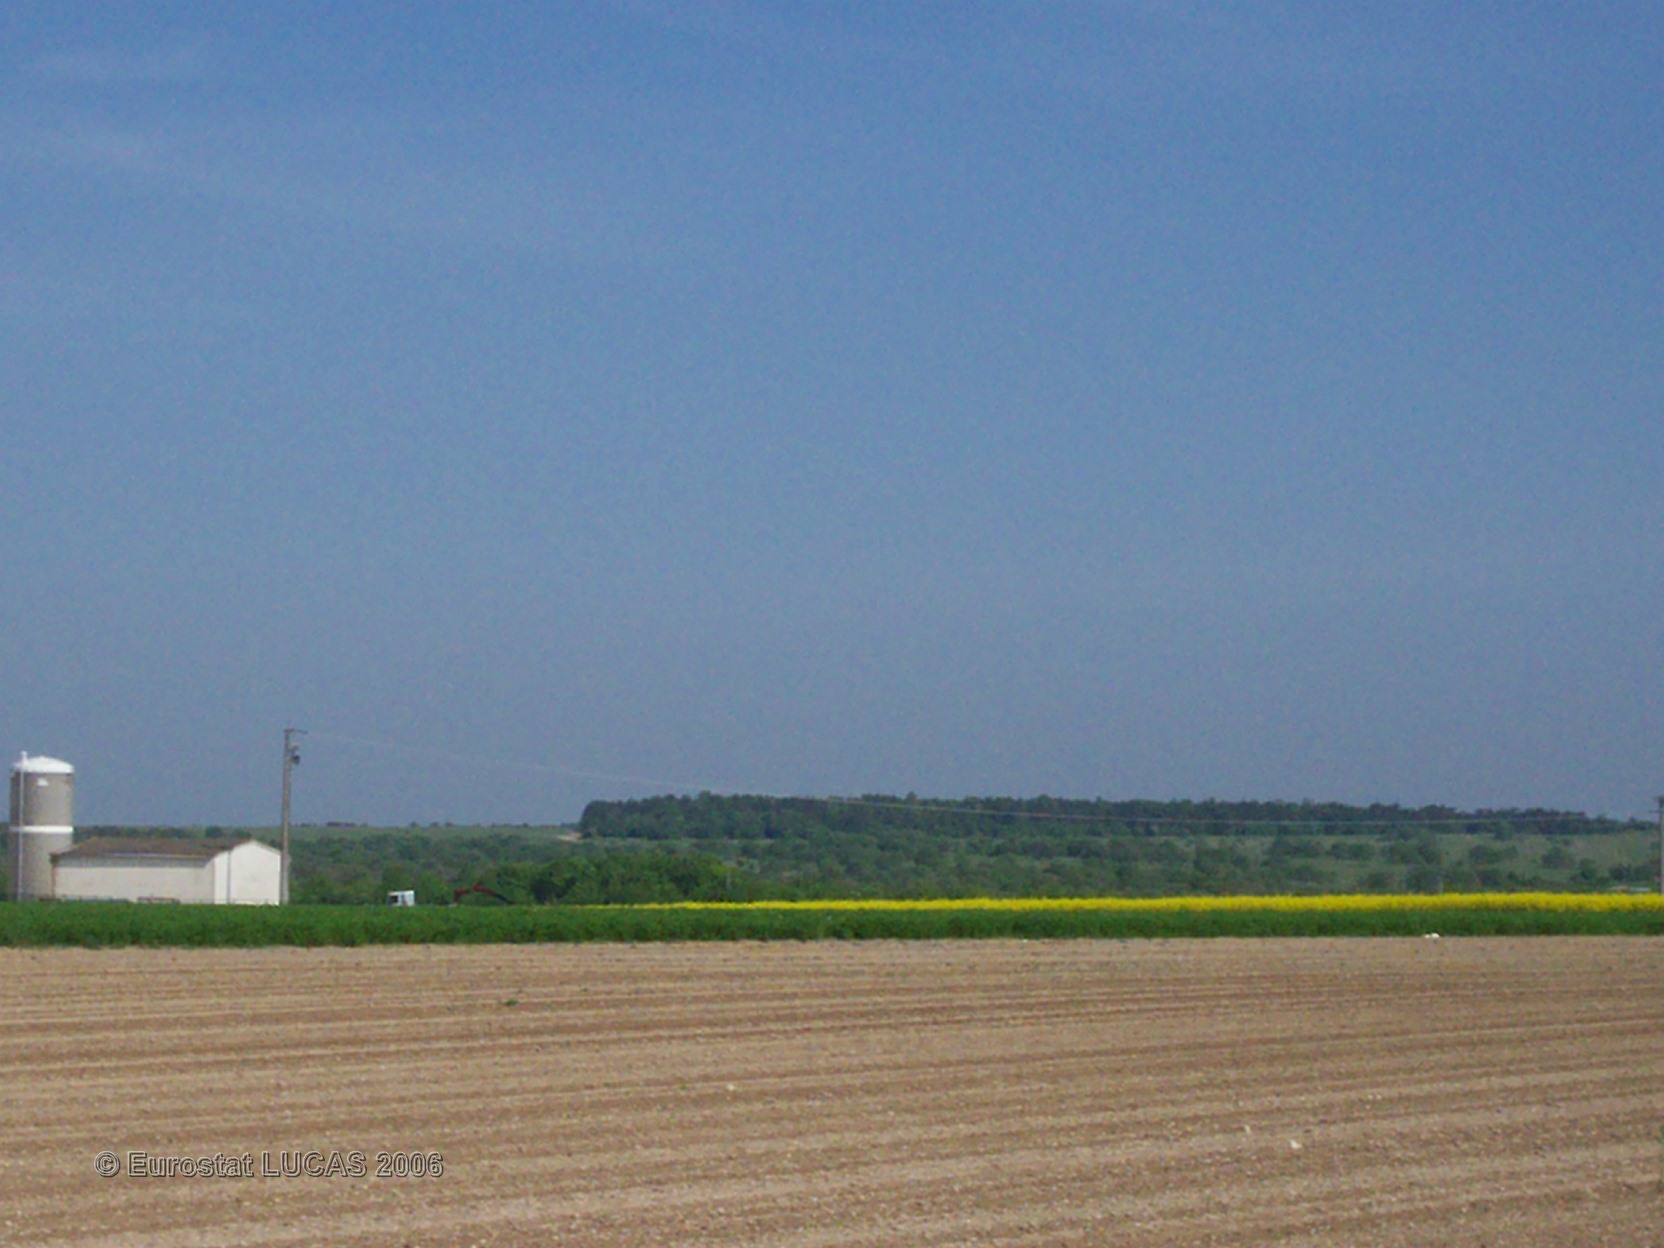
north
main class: Cropland
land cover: Sugar beet
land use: Agriculture (excluding fallow land and kitchen gardens)
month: May
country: FR
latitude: 49.0578
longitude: 4.4542
